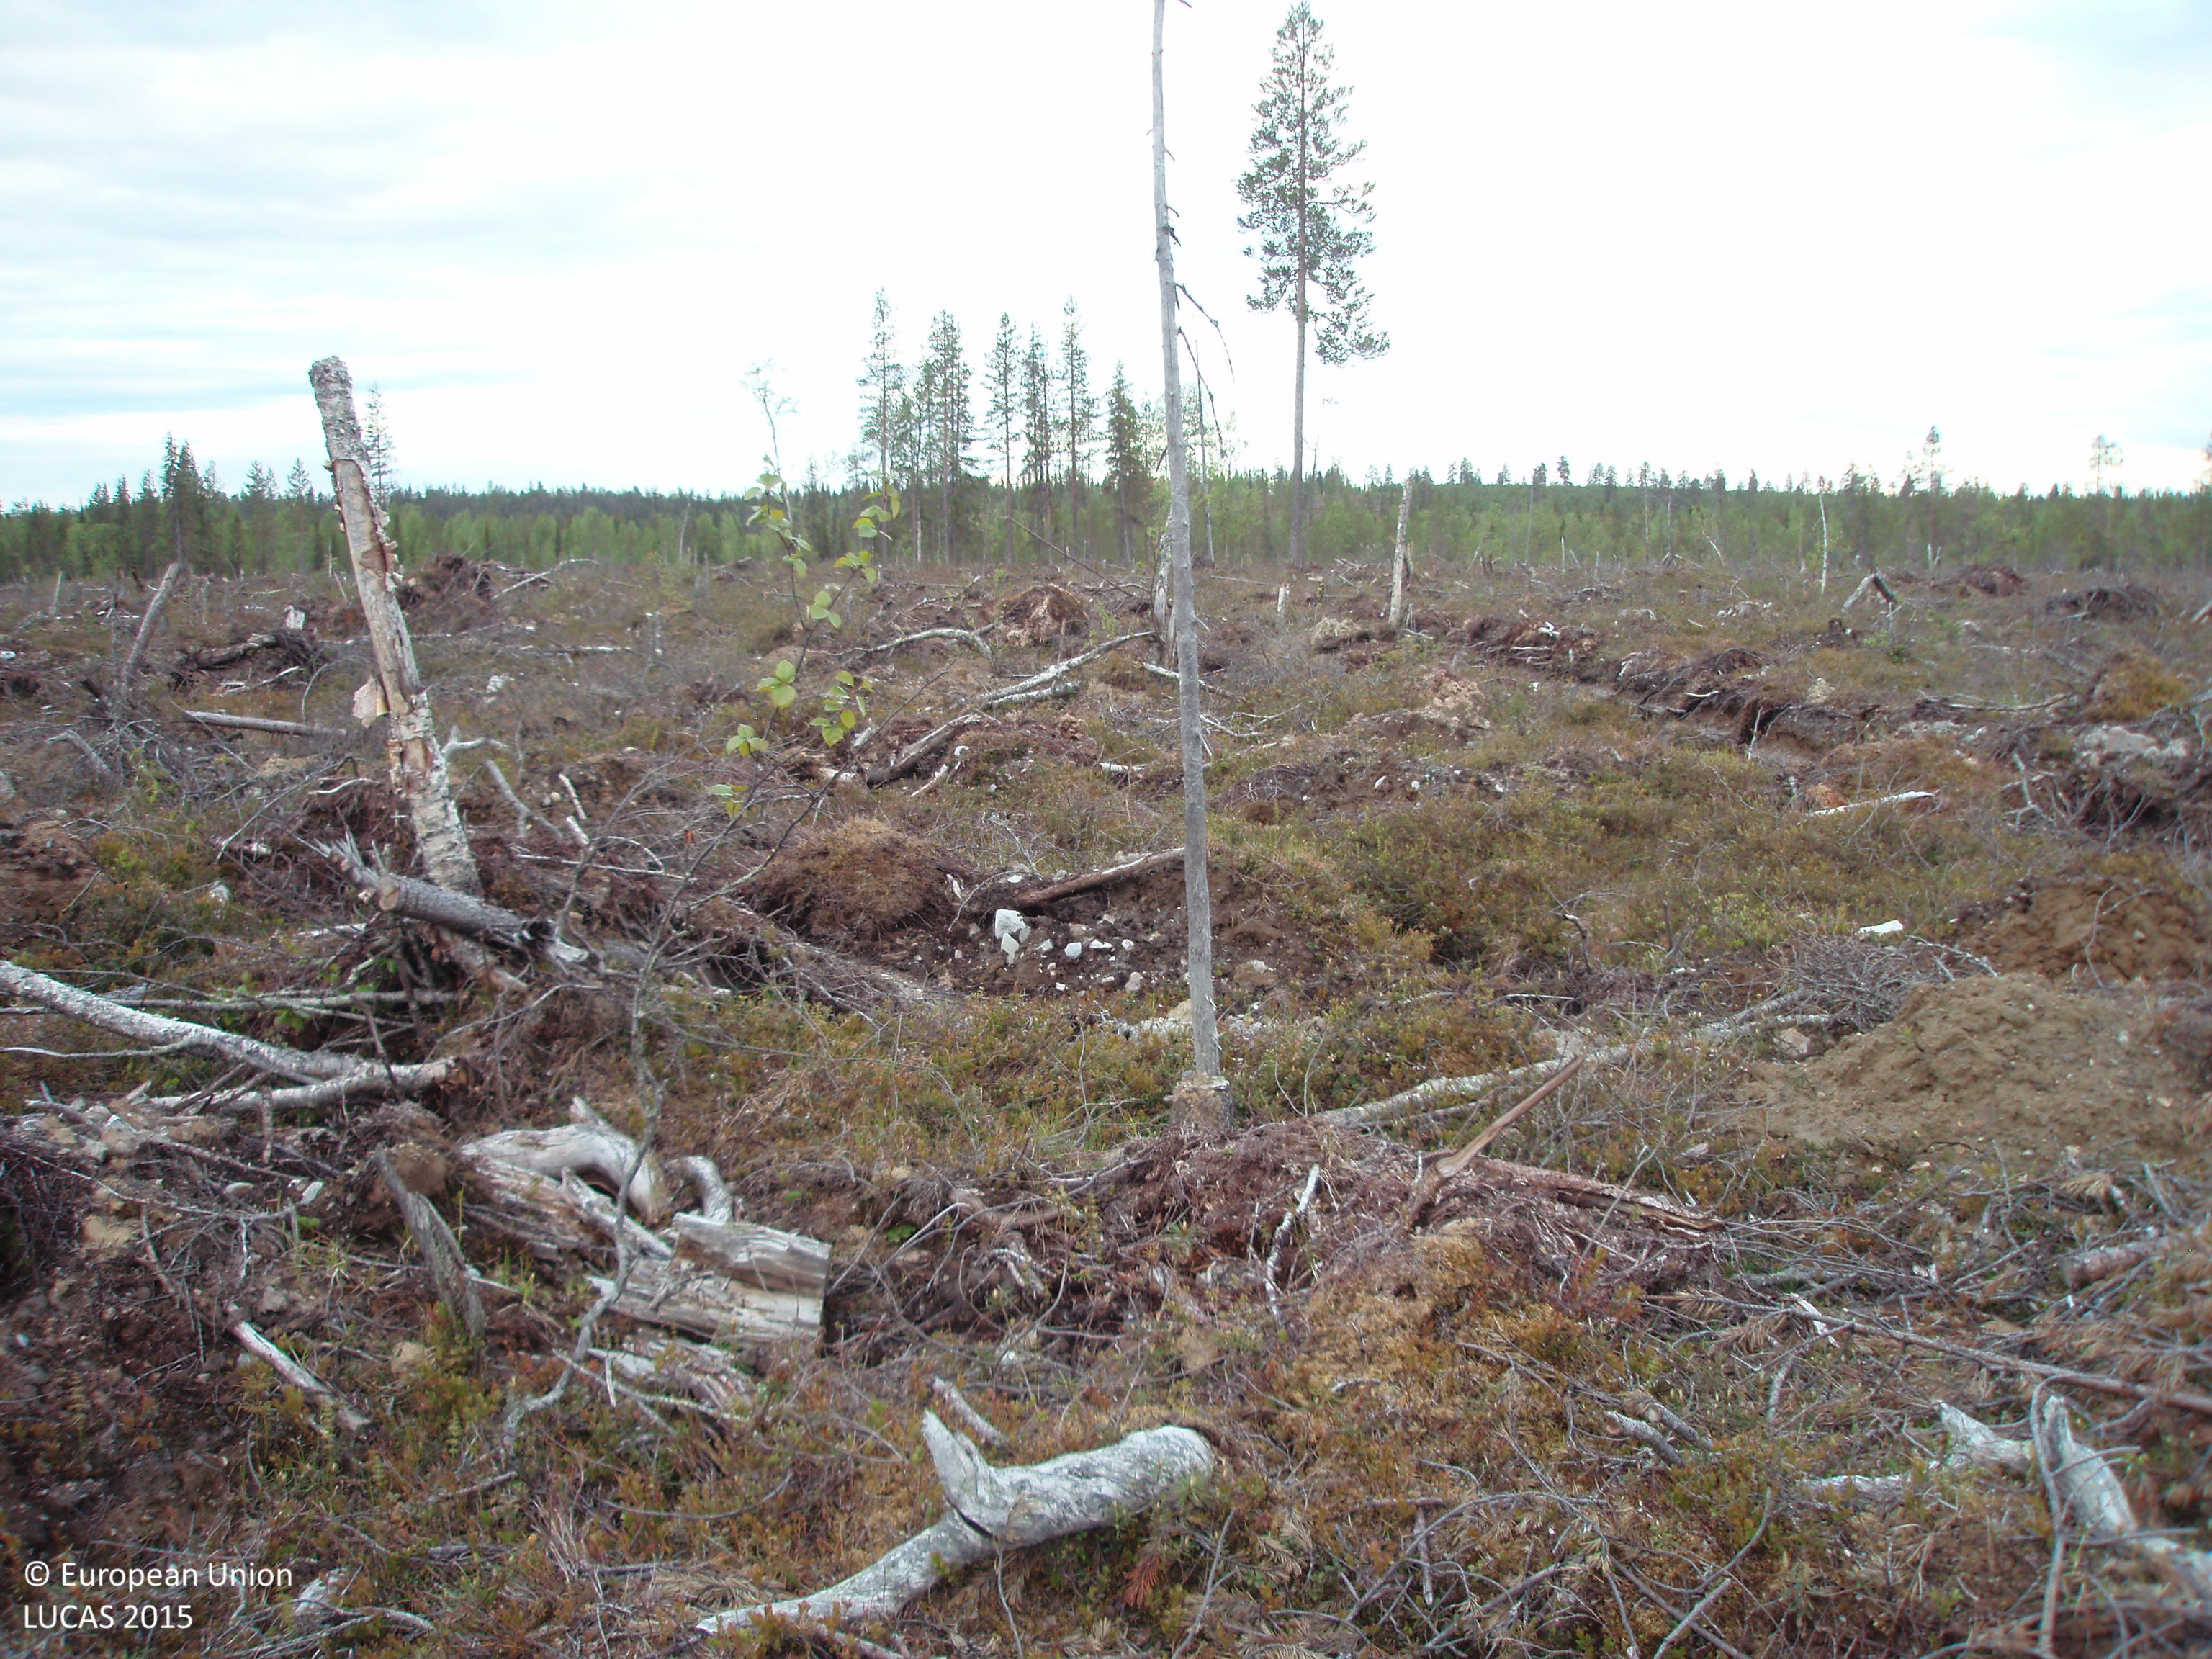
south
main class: Shrubland
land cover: Shrubland without tree cover
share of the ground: > 75 %
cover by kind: shrubs 90 %, unconsolidated bare surface 10 %
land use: Forestry
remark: Clear cut
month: June
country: FI
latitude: 67.3506
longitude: 27.2910
